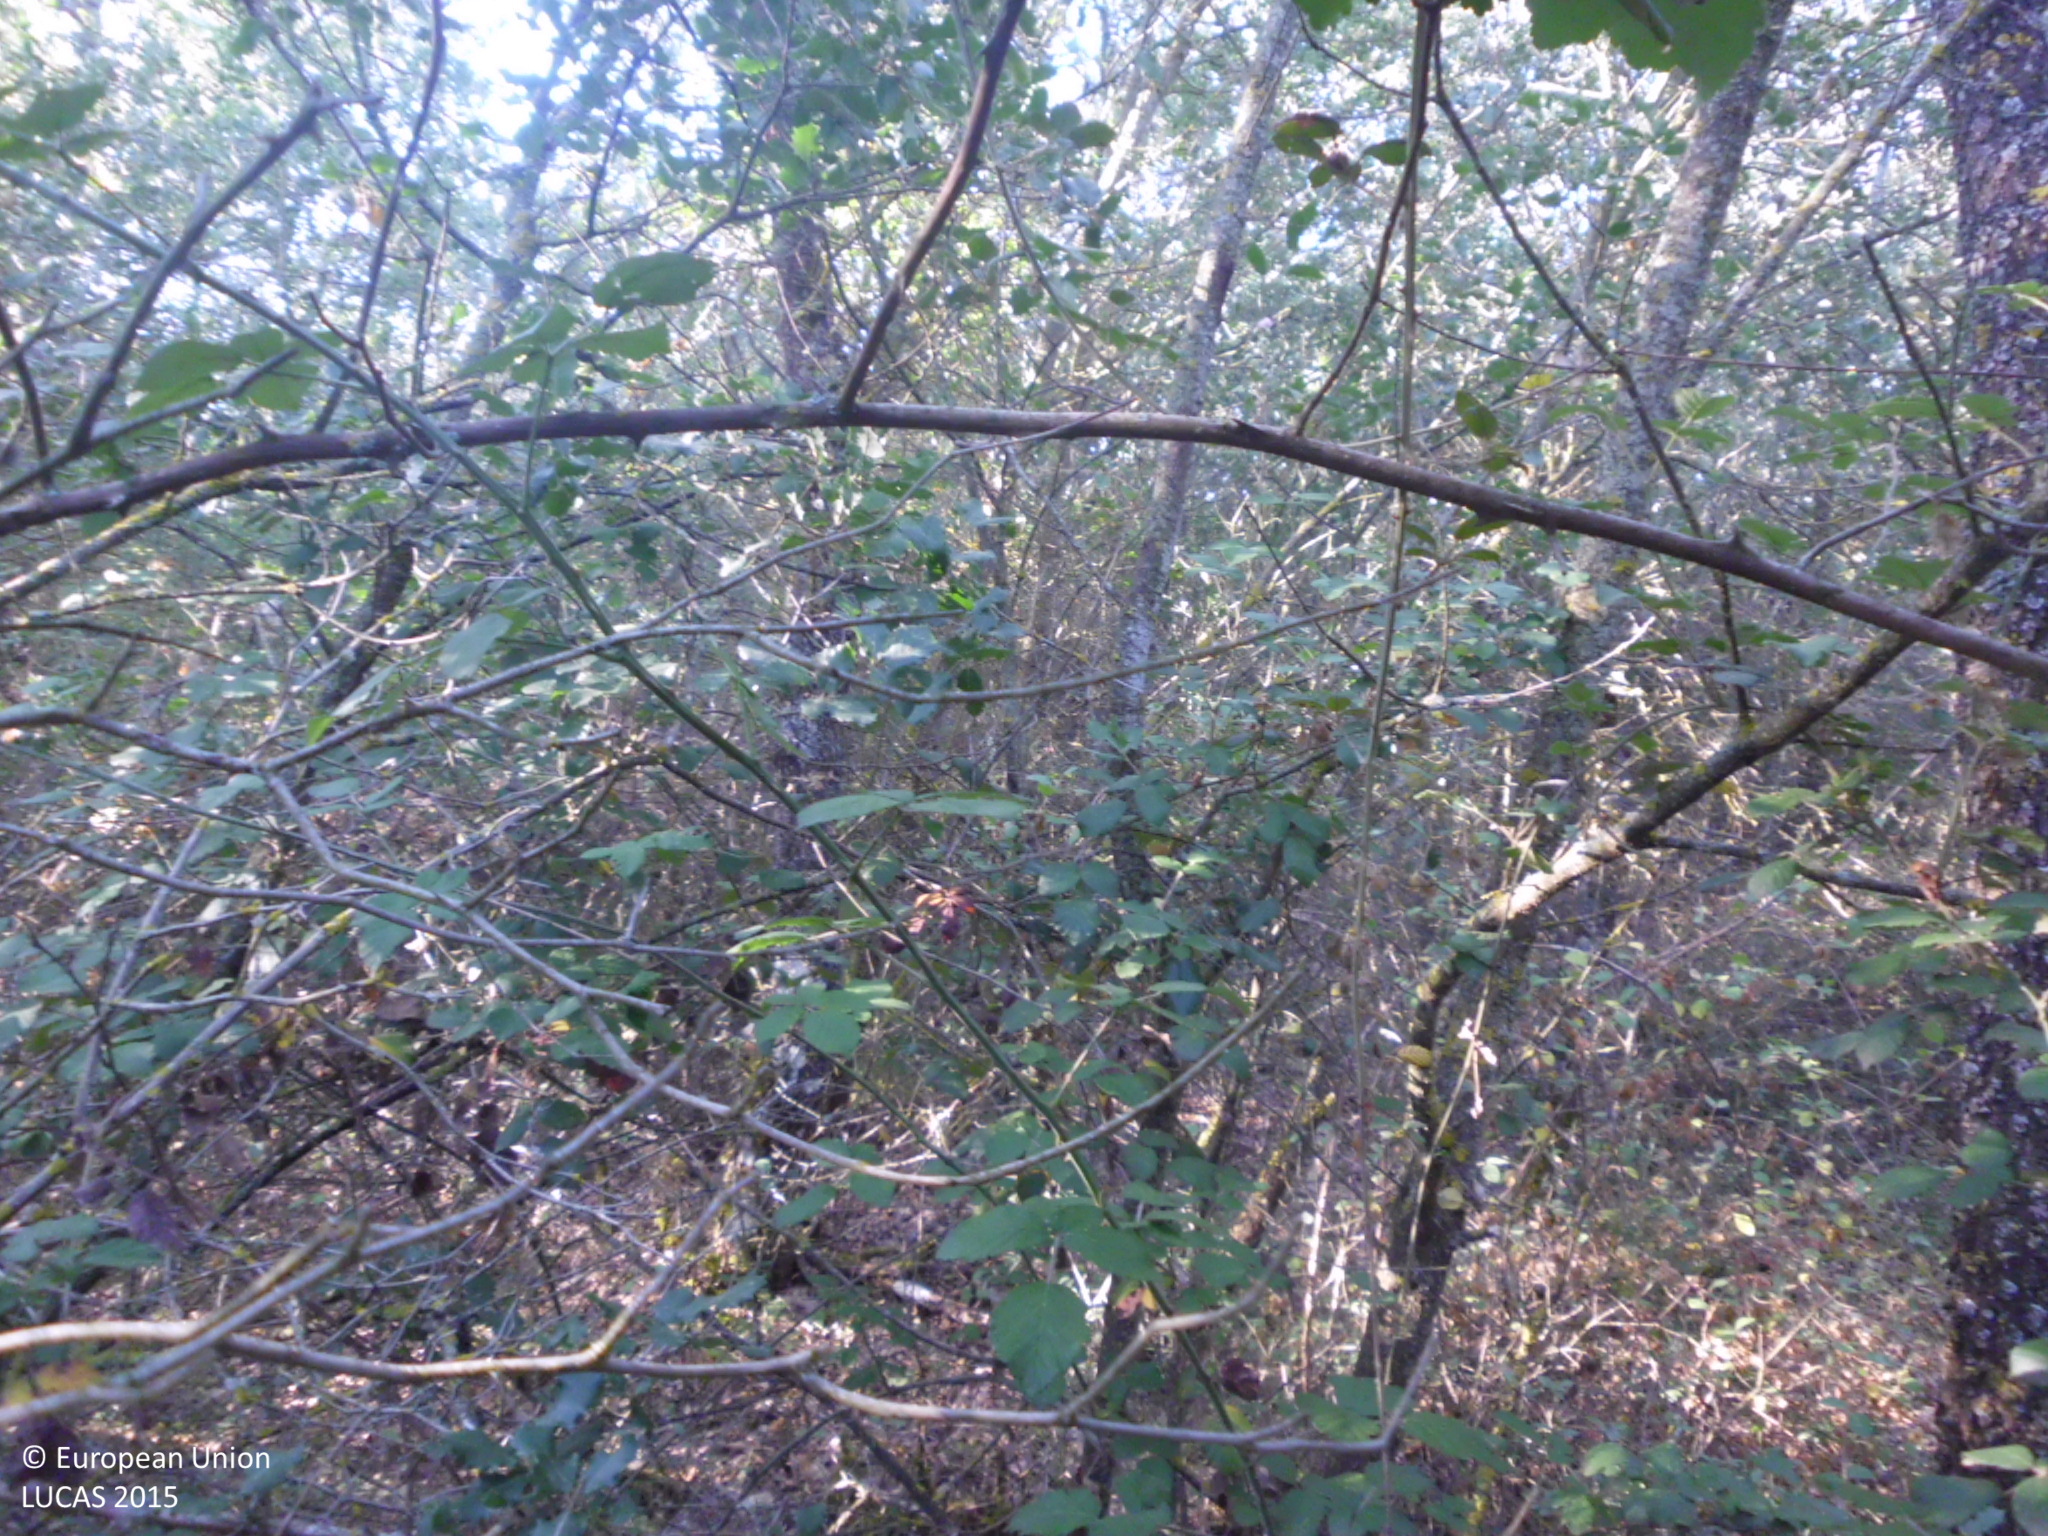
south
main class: Woodland
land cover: Broadleaved woodland
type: broadleaved evergreen forest
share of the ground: > 75 %
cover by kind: broadleaved forest trees 100 %
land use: Forestry
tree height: > 5 m
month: July
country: ES
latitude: 42.2736
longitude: -3.6510
